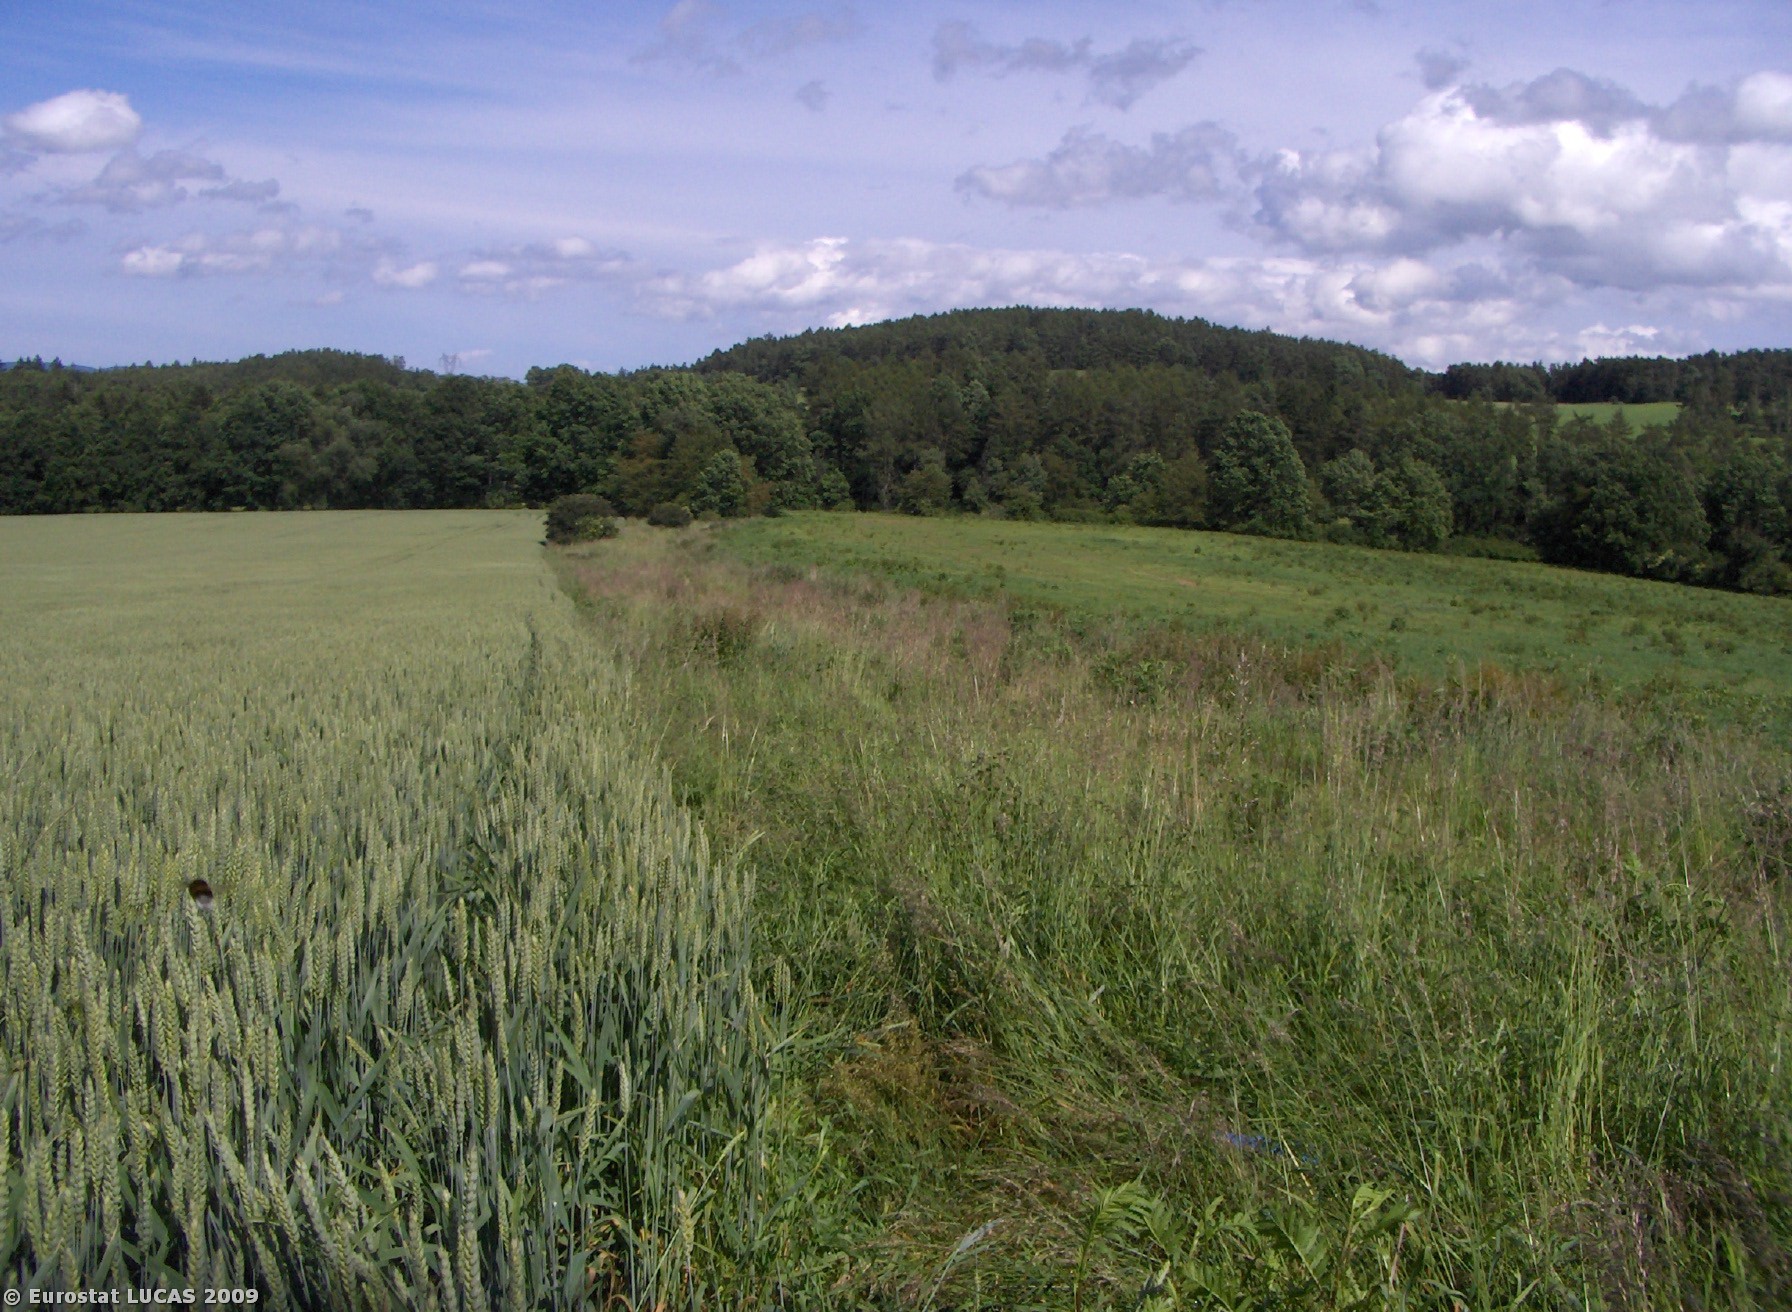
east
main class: Cropland
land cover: Common wheat
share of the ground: > 75 %
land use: Agriculture (excluding fallow land and kitchen gardens)
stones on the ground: < 10 %
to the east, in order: Common wheat; Grassland without tree/shrub cover
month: June
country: CZ
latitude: 49.2120
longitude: 14.0502
